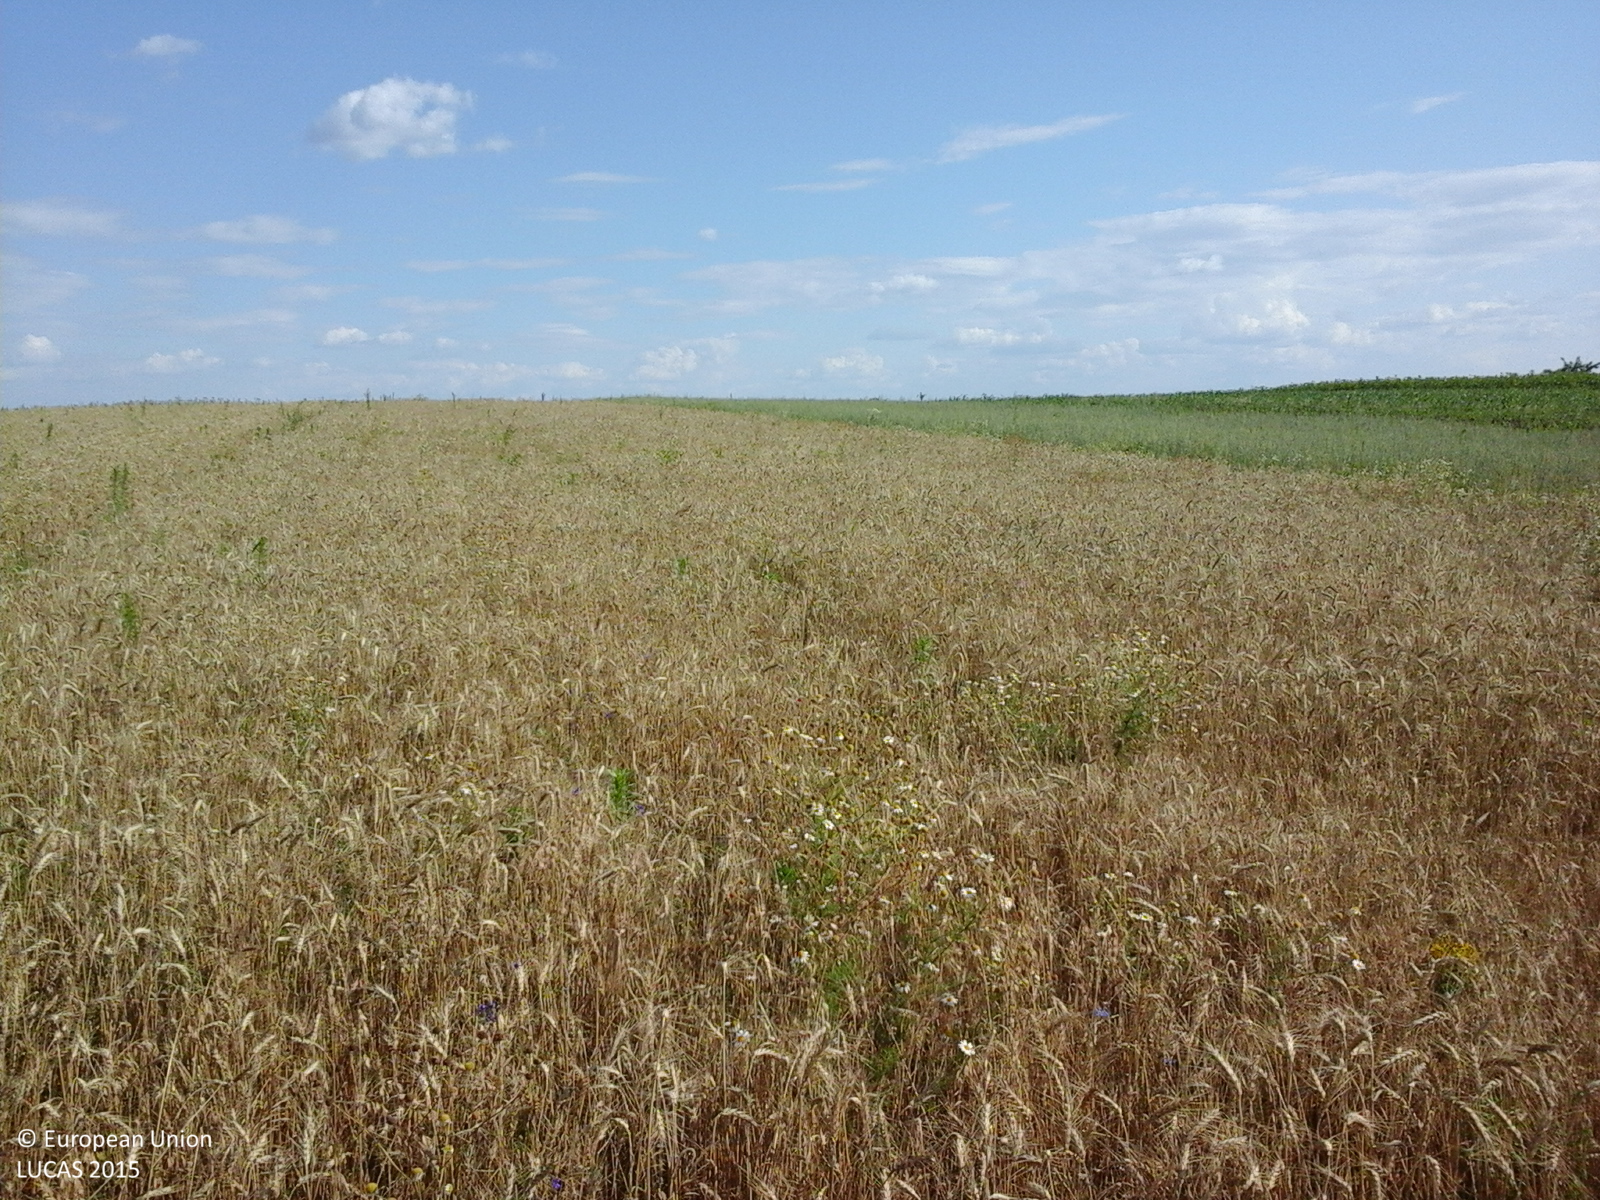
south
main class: Cropland
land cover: Common wheat
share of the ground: > 75 %
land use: Agriculture (excluding fallow land and kitchen gardens)
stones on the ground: < 10 %
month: July
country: RO
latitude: 44.3248
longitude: 24.8094
